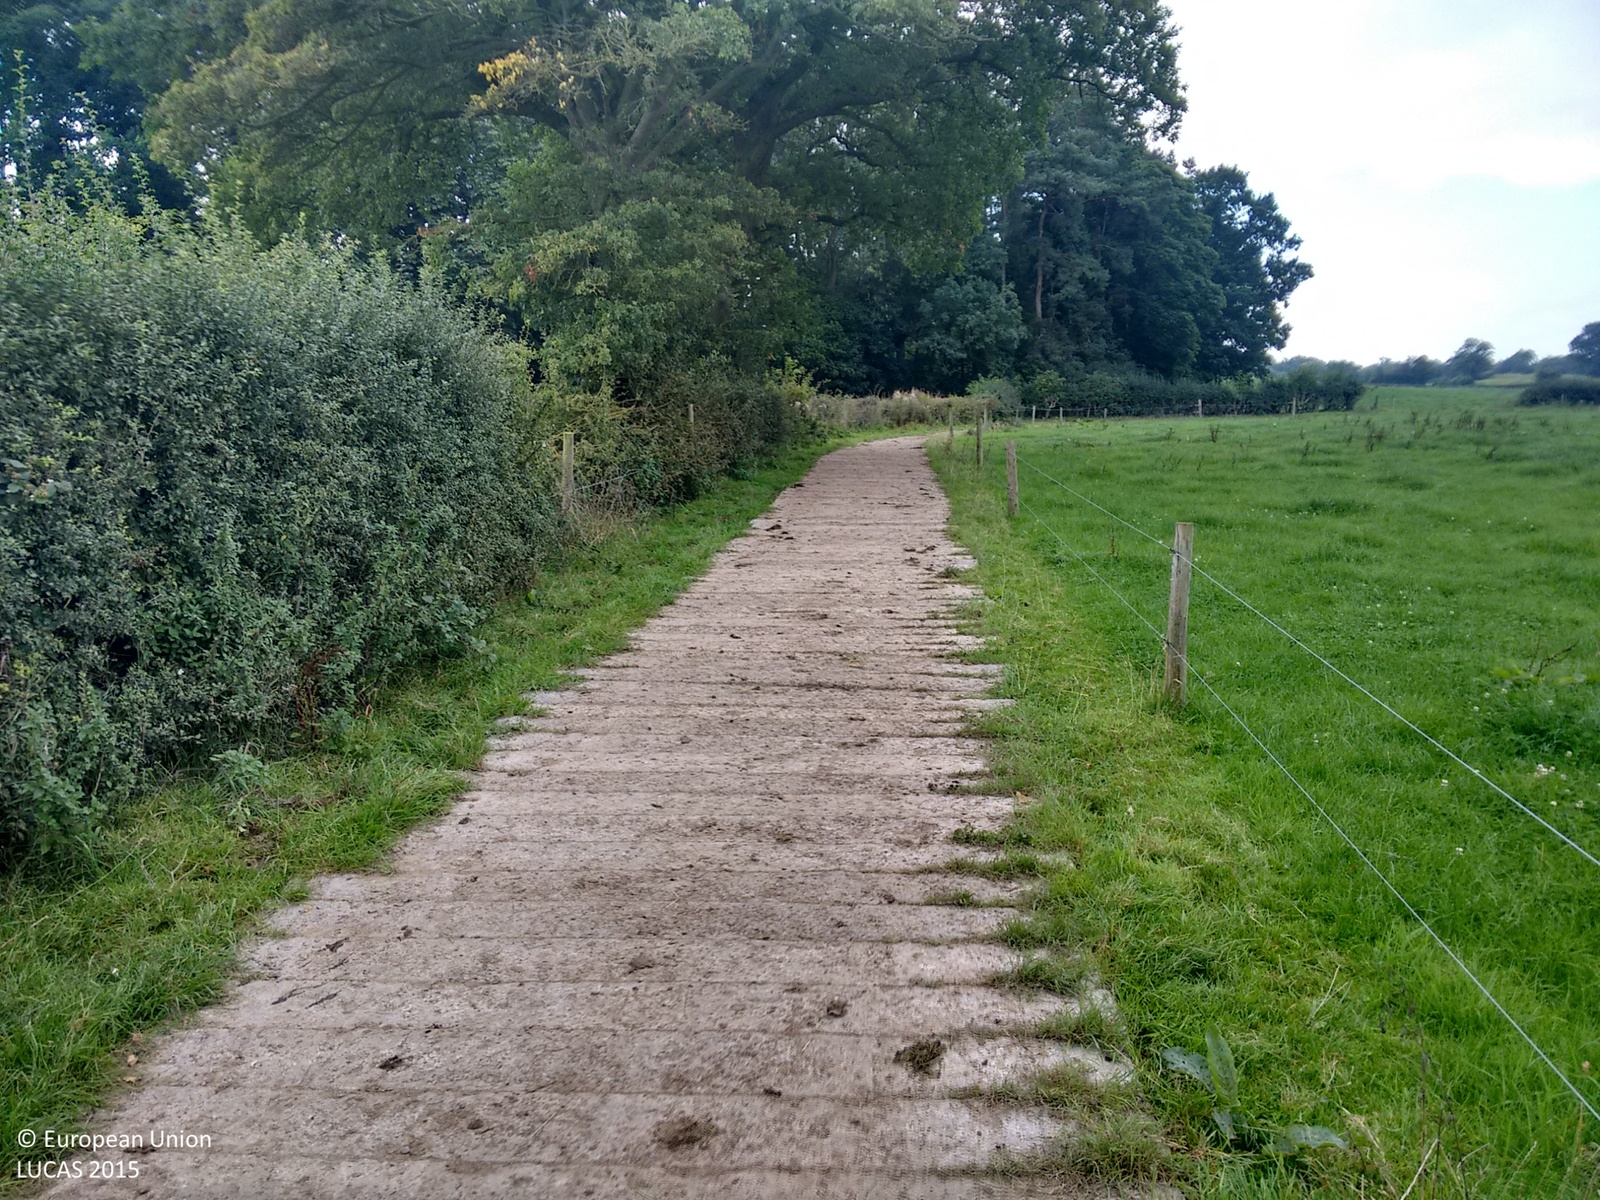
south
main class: Grassland
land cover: Grassland without tree/shrub cover
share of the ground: > 75 %
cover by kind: herbaceous plants 100 %
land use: Agriculture (excluding fallow land and kitchen gardens)
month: September
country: GB
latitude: 52.9049
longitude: -2.9343
